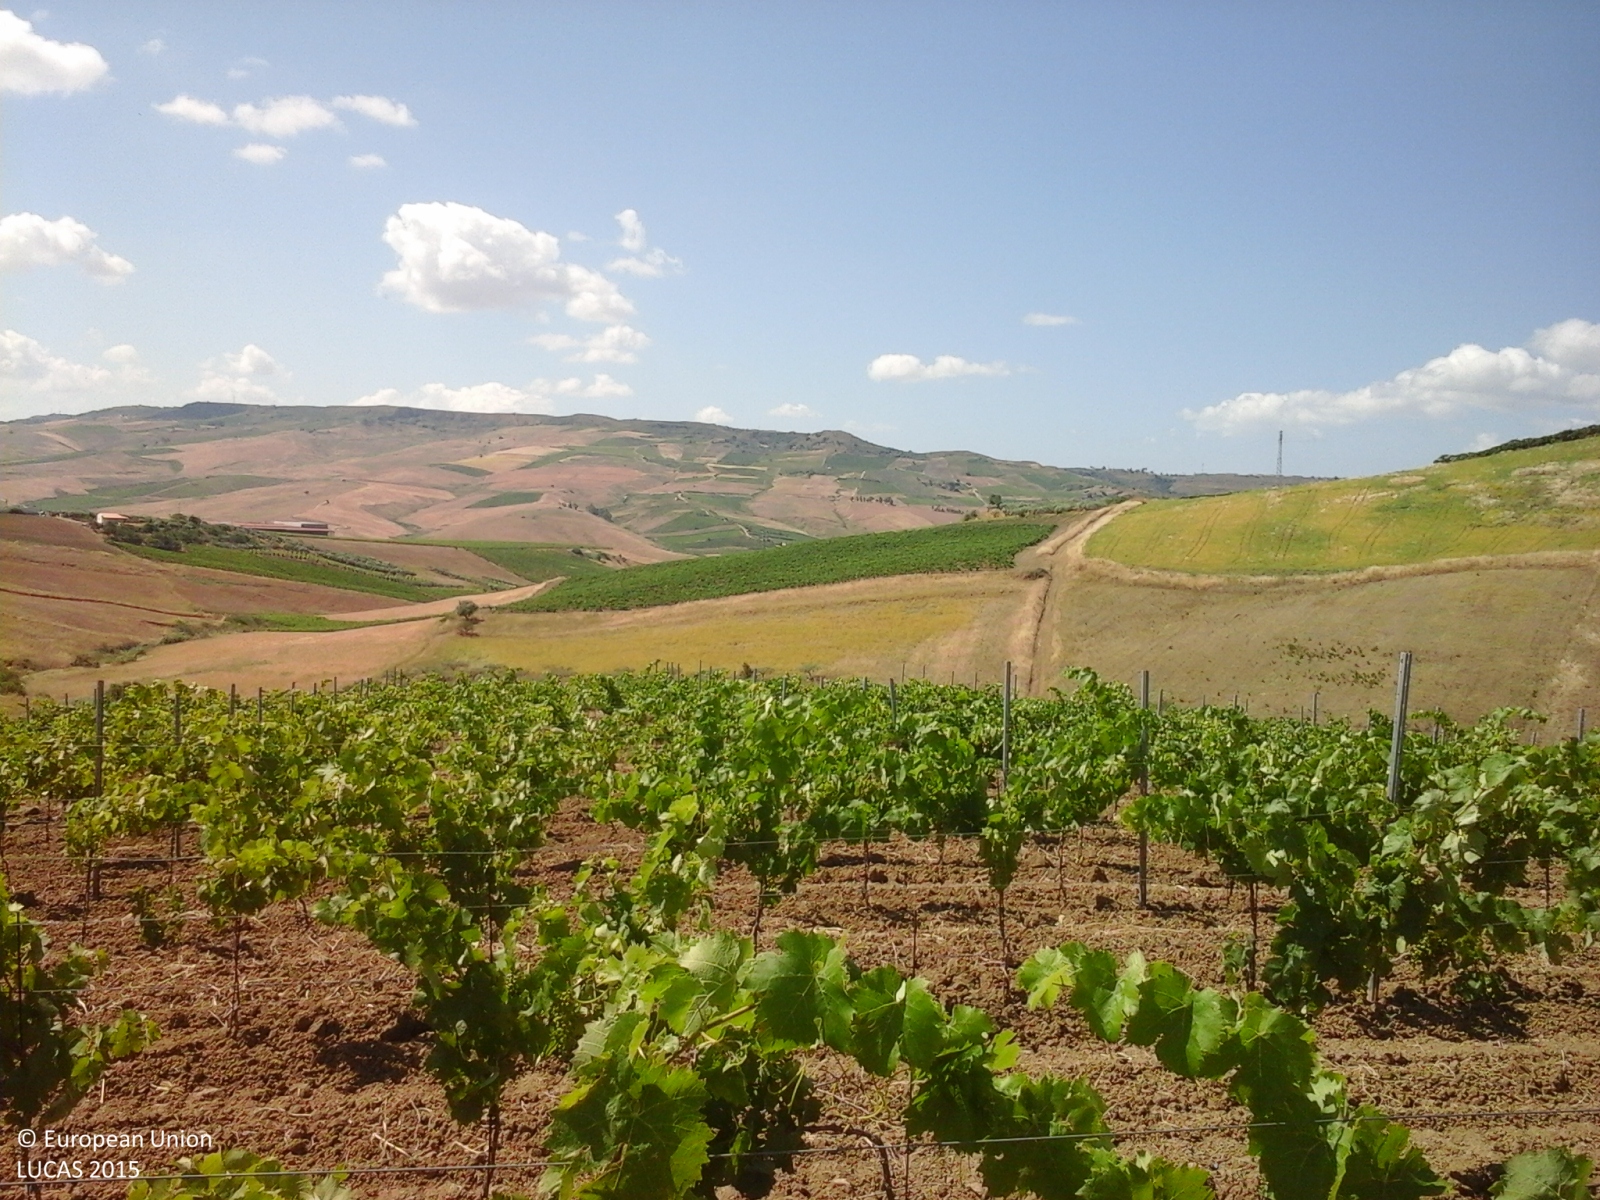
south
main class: Cropland
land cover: Vineyards
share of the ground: 25 - 50 %
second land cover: Other bare soil
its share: > 75 %
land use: Agriculture (excluding fallow land and kitchen gardens)
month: June
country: IT
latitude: 37.7552
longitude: 12.9856
